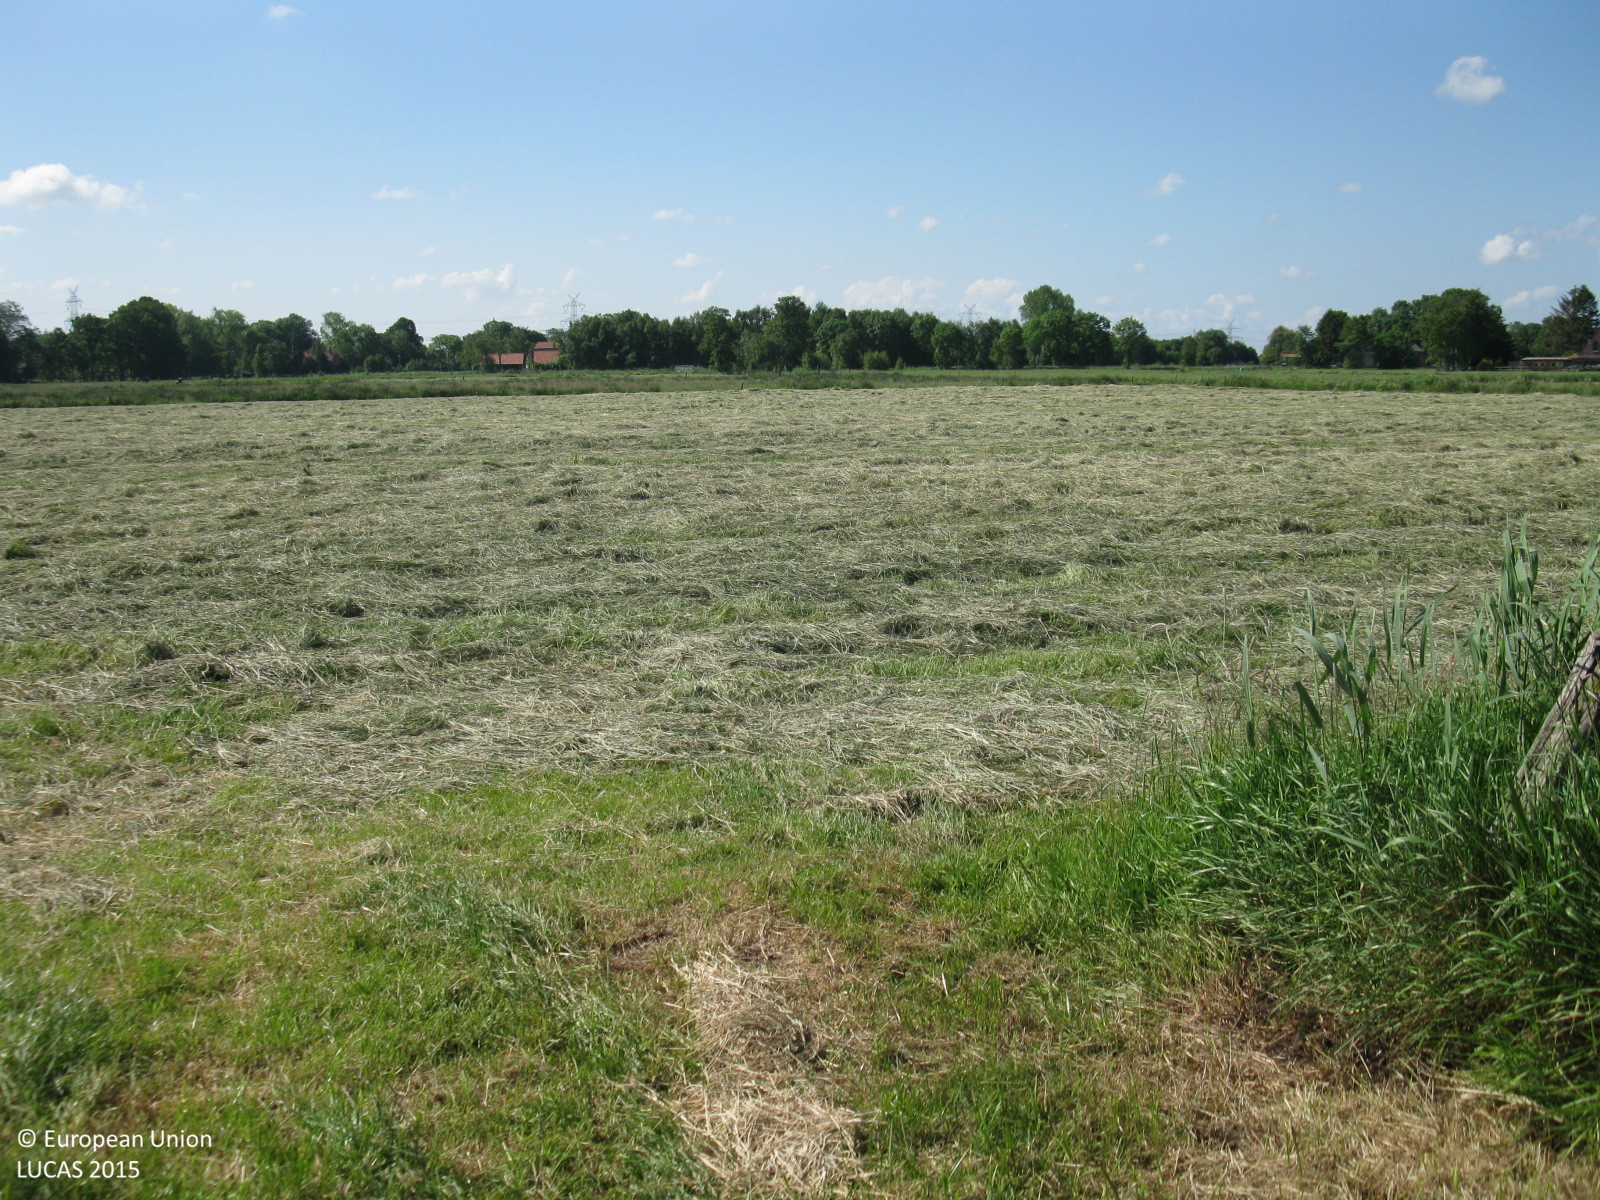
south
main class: Grassland
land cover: Grassland without tree/shrub cover
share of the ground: > 75 %
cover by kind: herbaceous plants 100 %
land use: Agriculture (excluding fallow land and kitchen gardens)
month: June
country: DE
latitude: 53.3904
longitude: 8.3316
